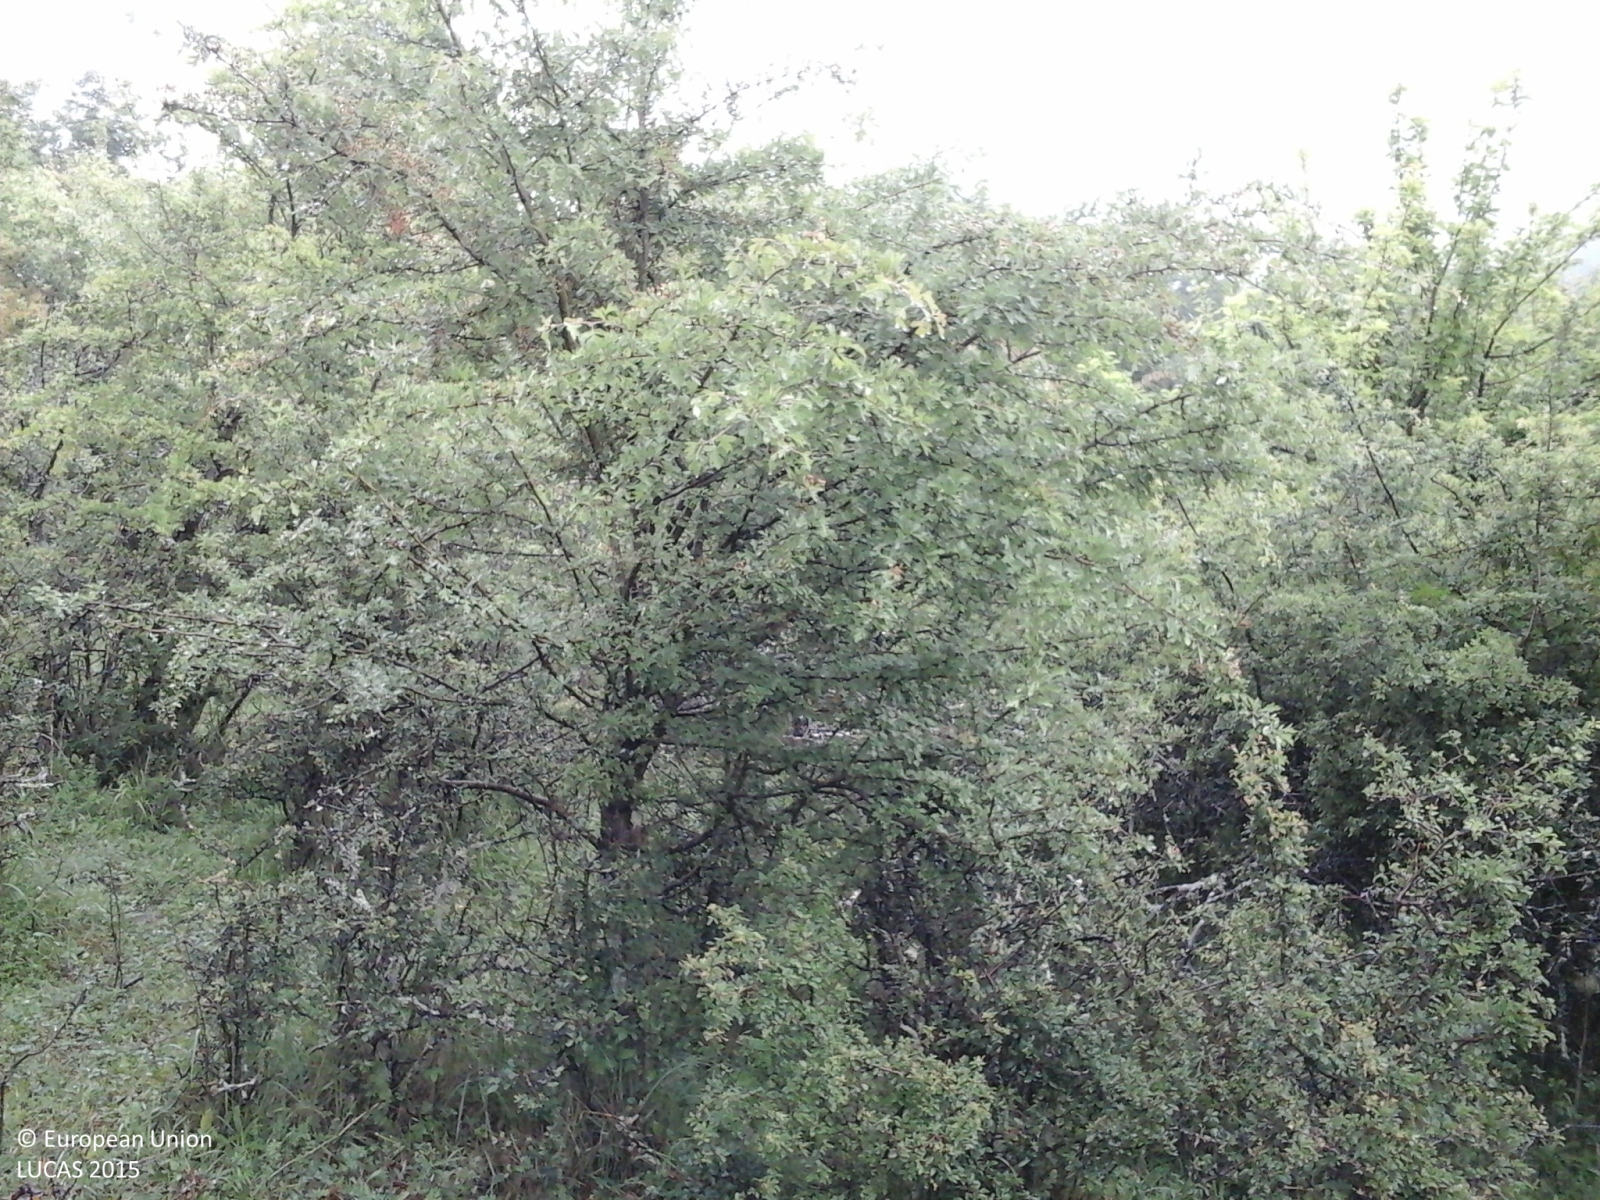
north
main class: Shrubland
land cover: Shrubland with sparse tree cover
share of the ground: 50 - 75 %
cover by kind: shrubs 85 %, herbaceous plants 10 %, broadleaved forest trees 5 %
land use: Forestry
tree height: < 5 m
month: May
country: IT
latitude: 41.6588
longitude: 13.8409
